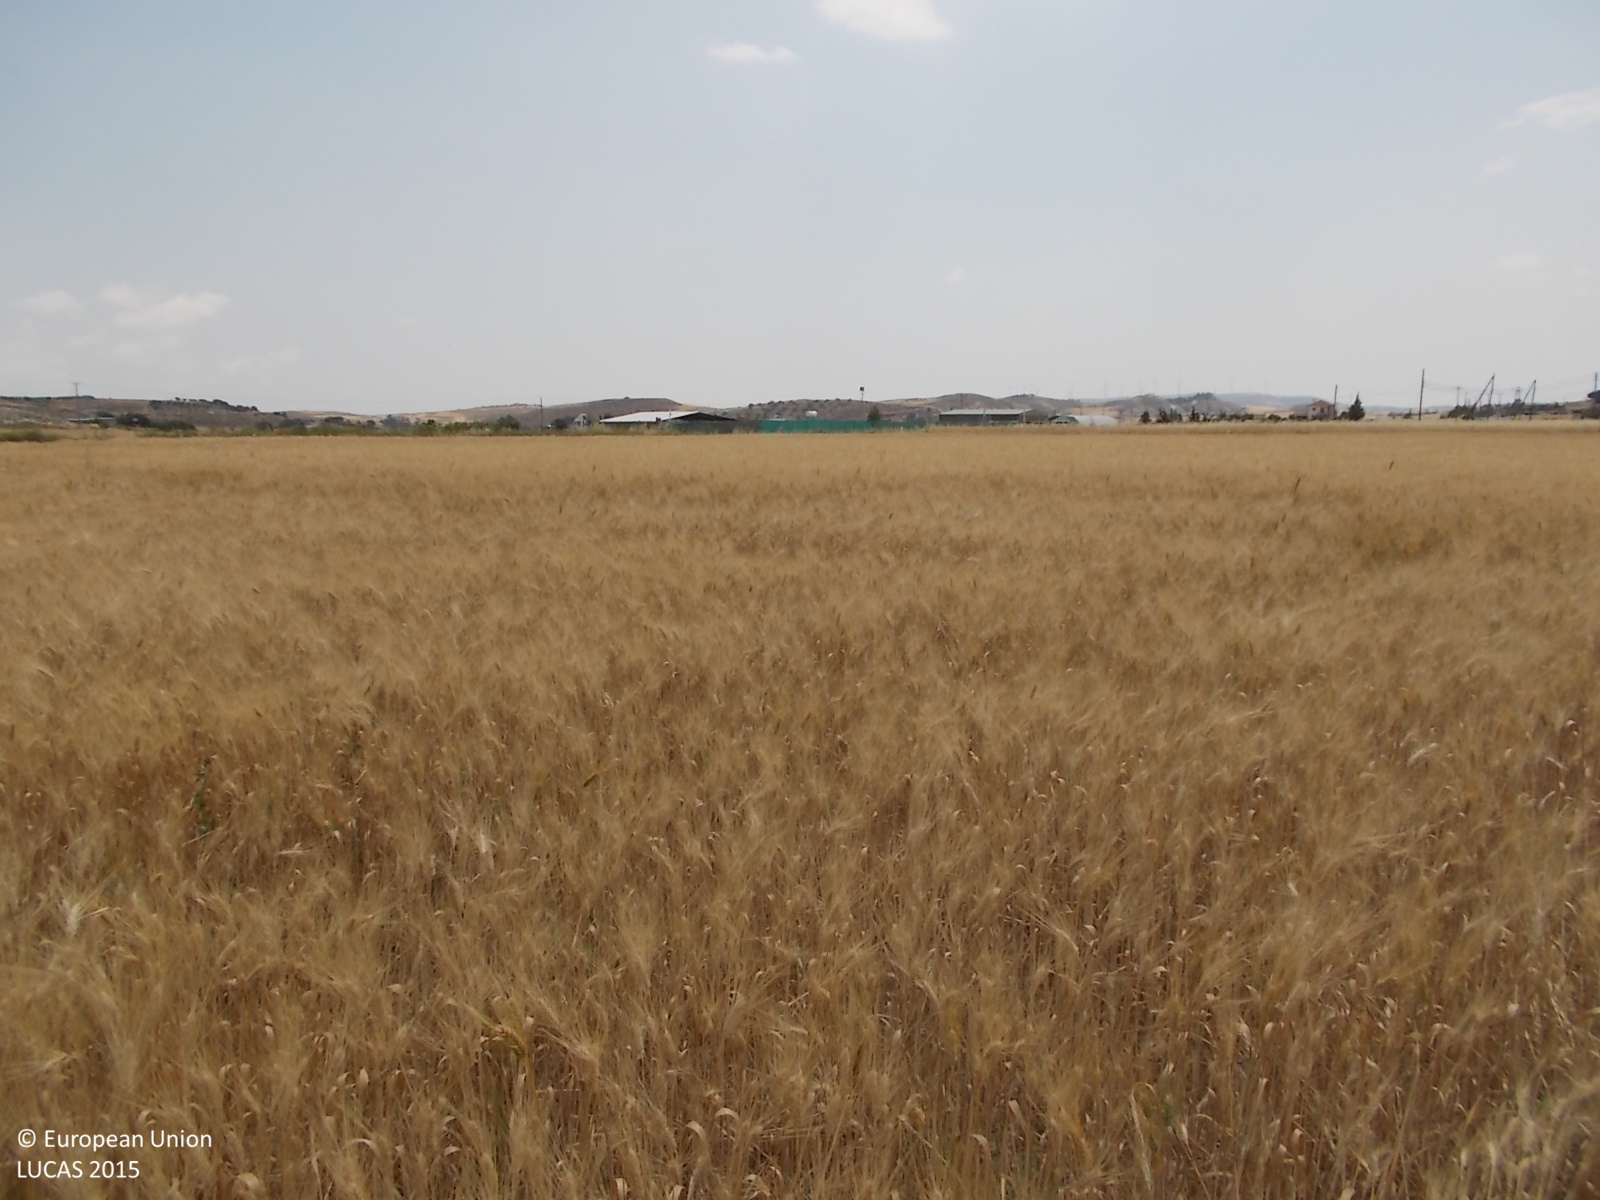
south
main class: Cropland
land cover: Durum wheat
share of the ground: > 75 %
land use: Agriculture (excluding fallow land and kitchen gardens)
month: May
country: CY
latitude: 34.9343
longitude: 33.5457
